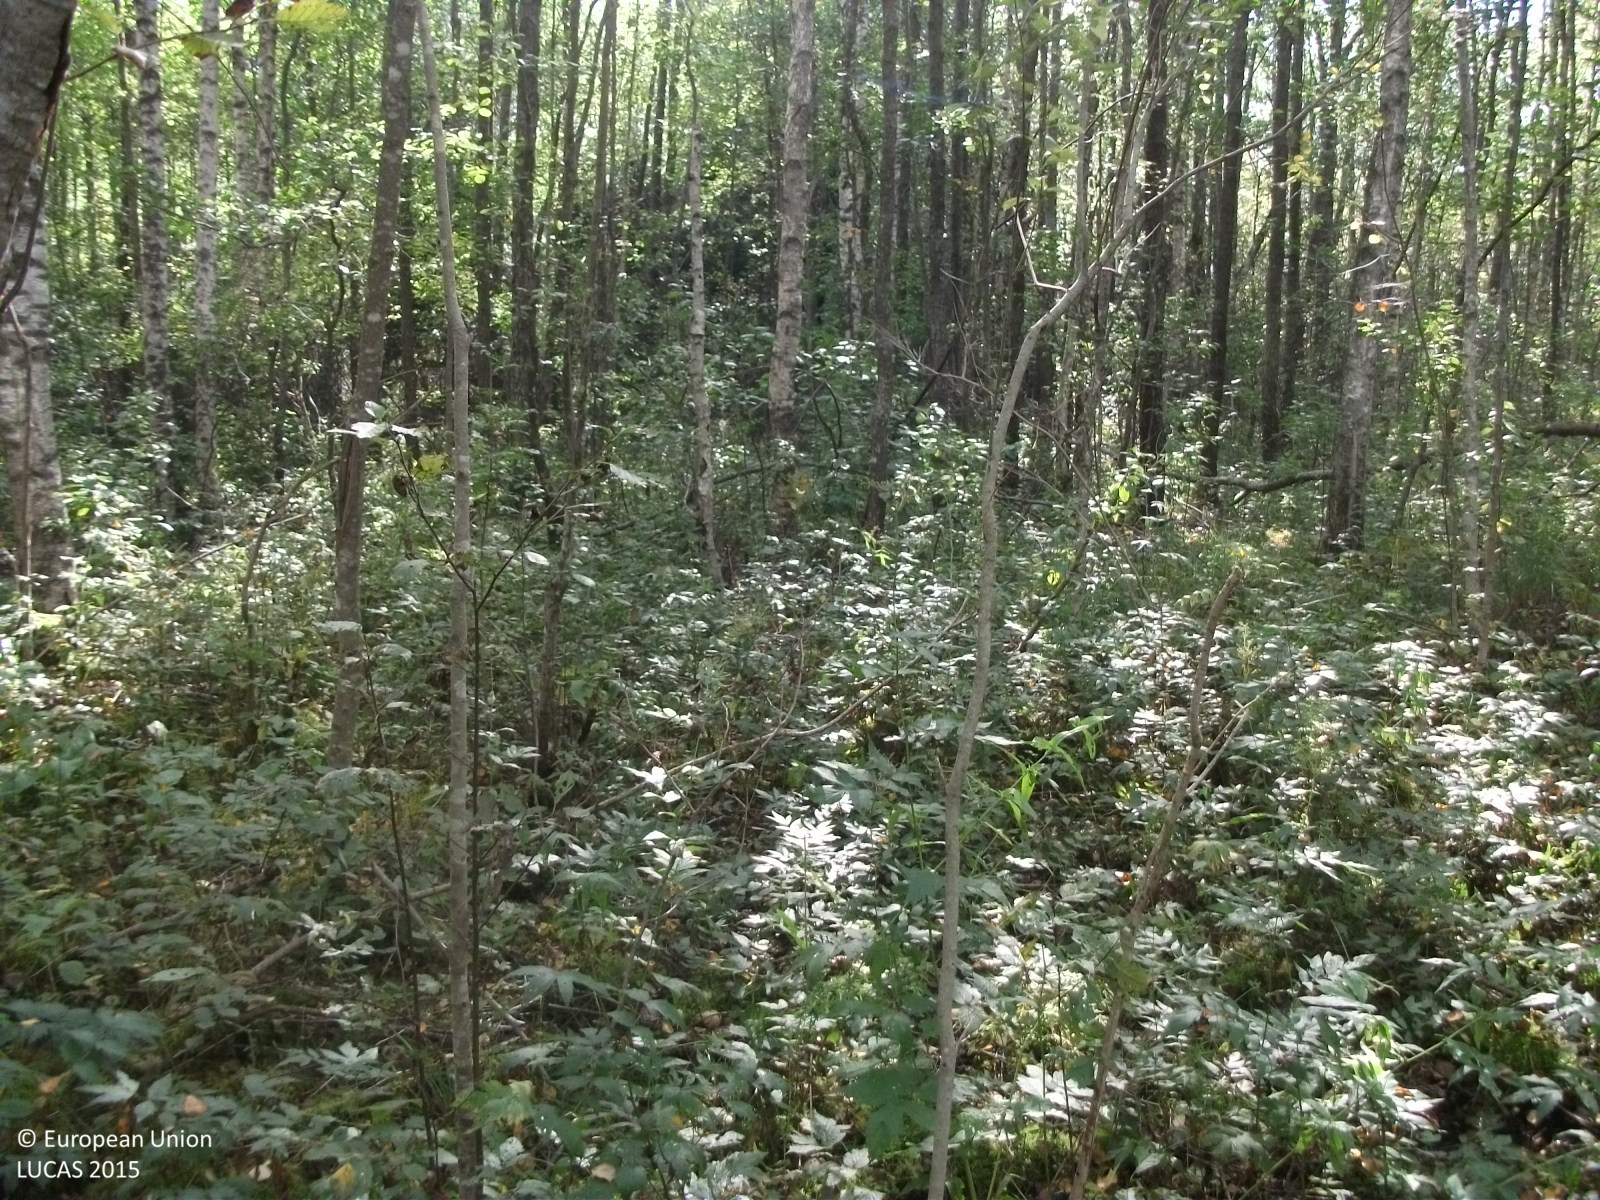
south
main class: Woodland
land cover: Broadleaved woodland
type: non-riverine alder, birch or aspen forest
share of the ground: > 75 %
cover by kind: broadleaved forest trees 90 %, shrubs 5 %, herbaceous plants 5 %
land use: Forestry
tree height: > 5 m
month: September
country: LV
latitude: 57.9628
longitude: 24.9555
